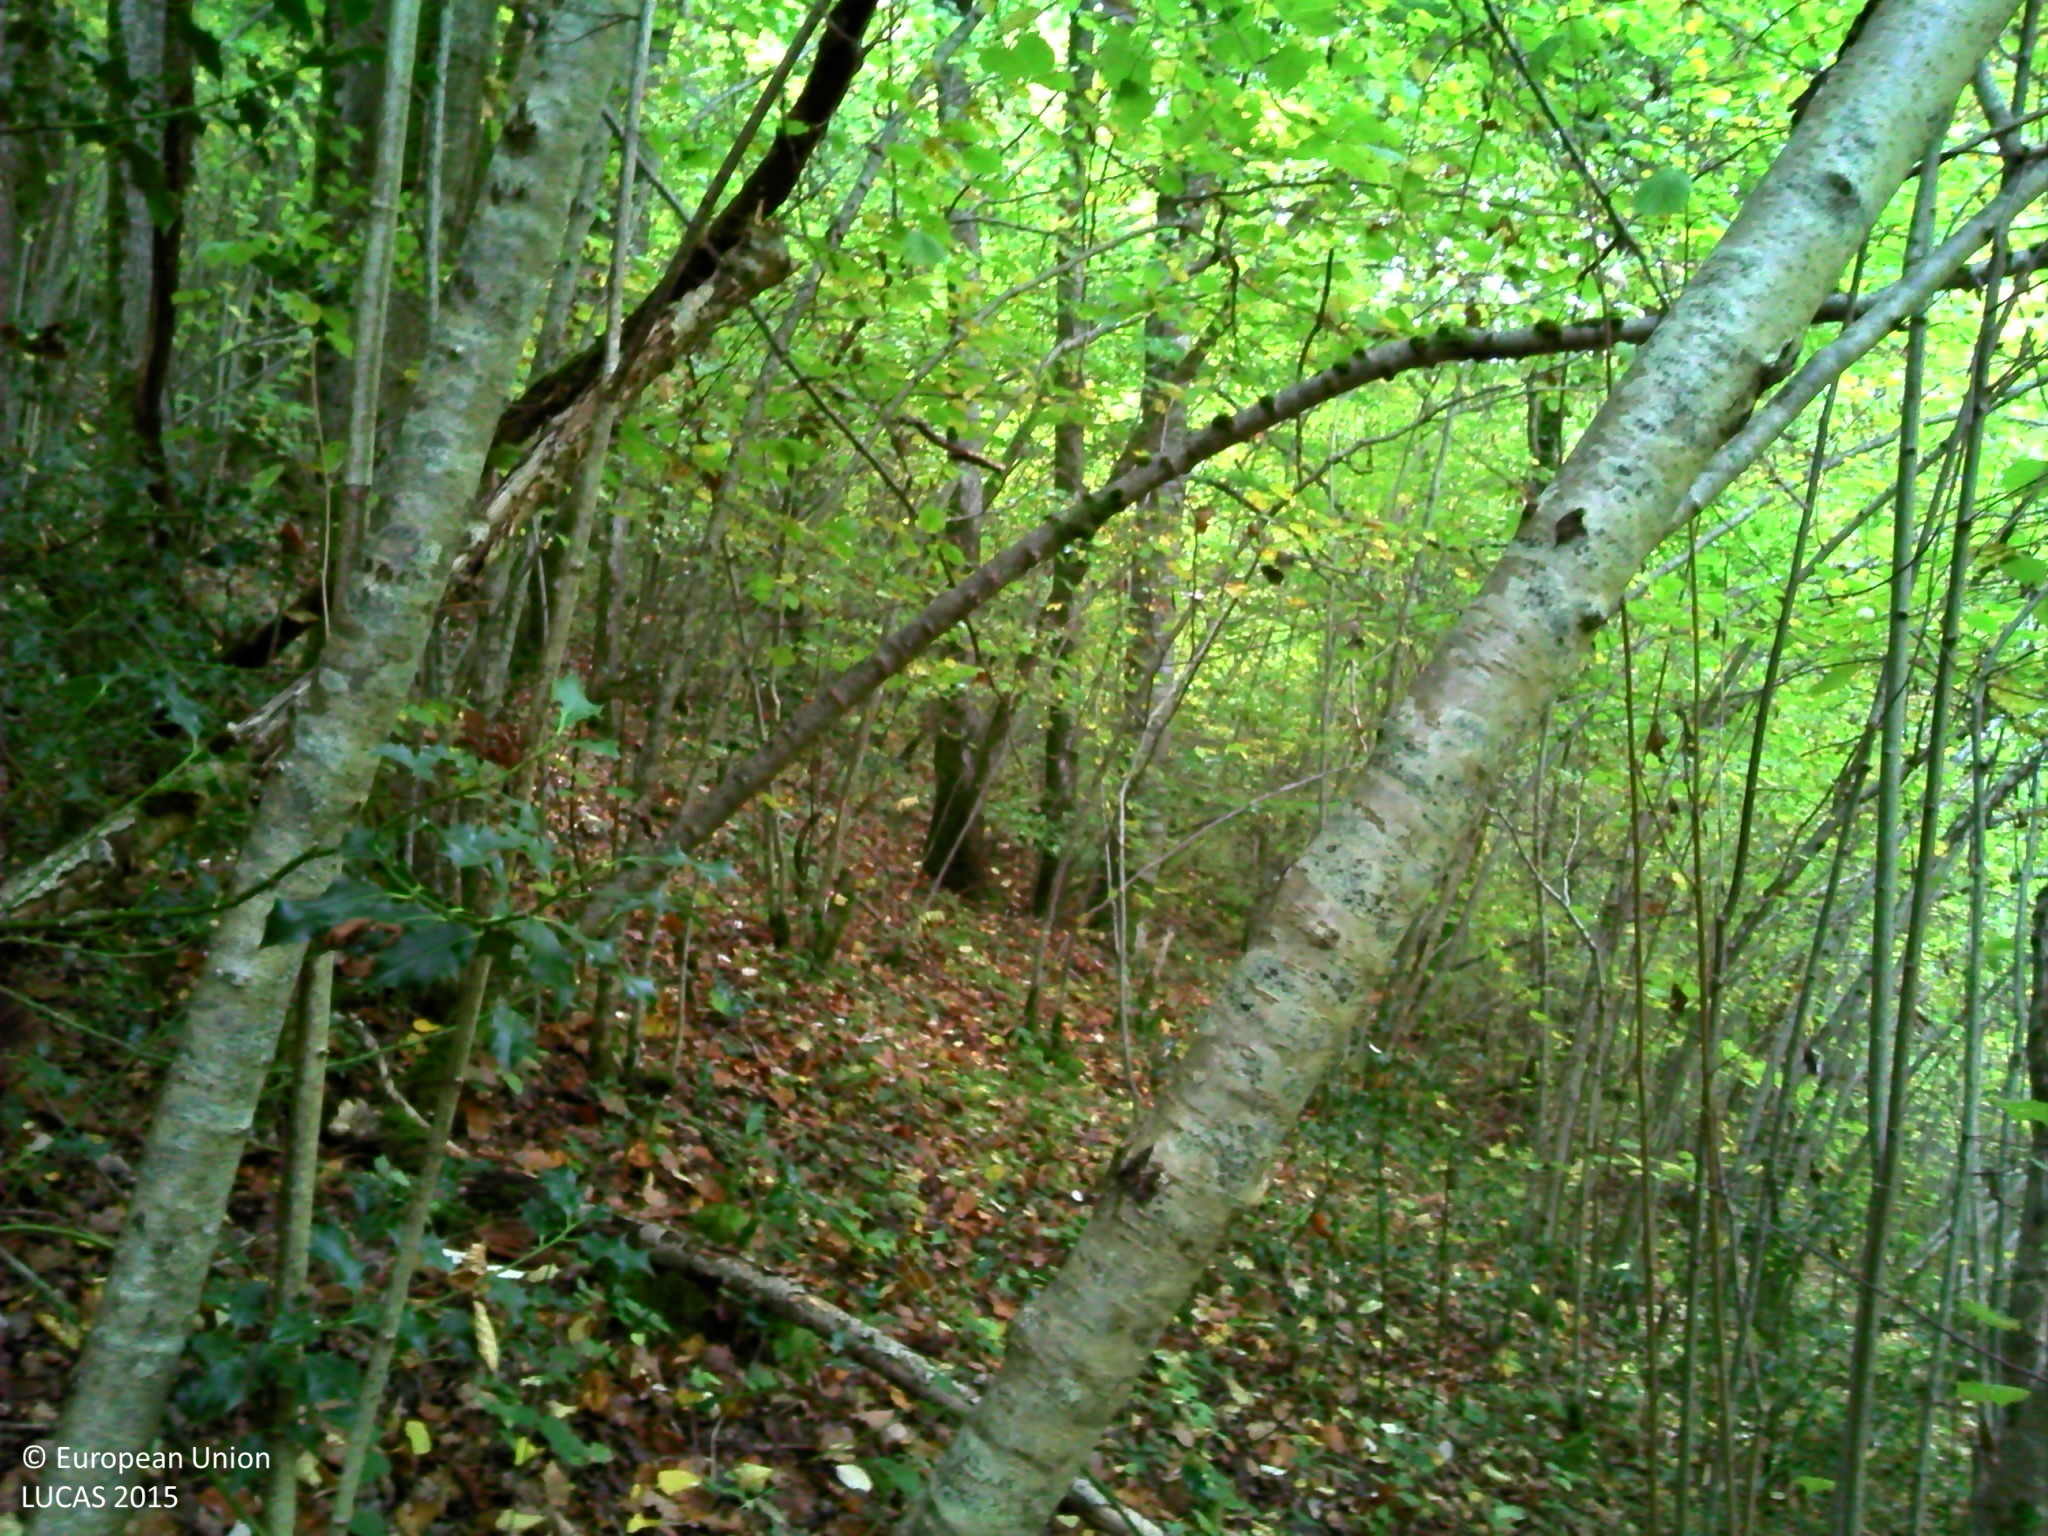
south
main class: Woodland
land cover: Broadleaved woodland
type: mesophytic deciduous forest
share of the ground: > 75 %
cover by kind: broadleaved forest trees 85 %, herbaceous plants 15 %
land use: Forestry
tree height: > 5 m
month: October
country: FR
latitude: 45.9466
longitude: 2.8129
